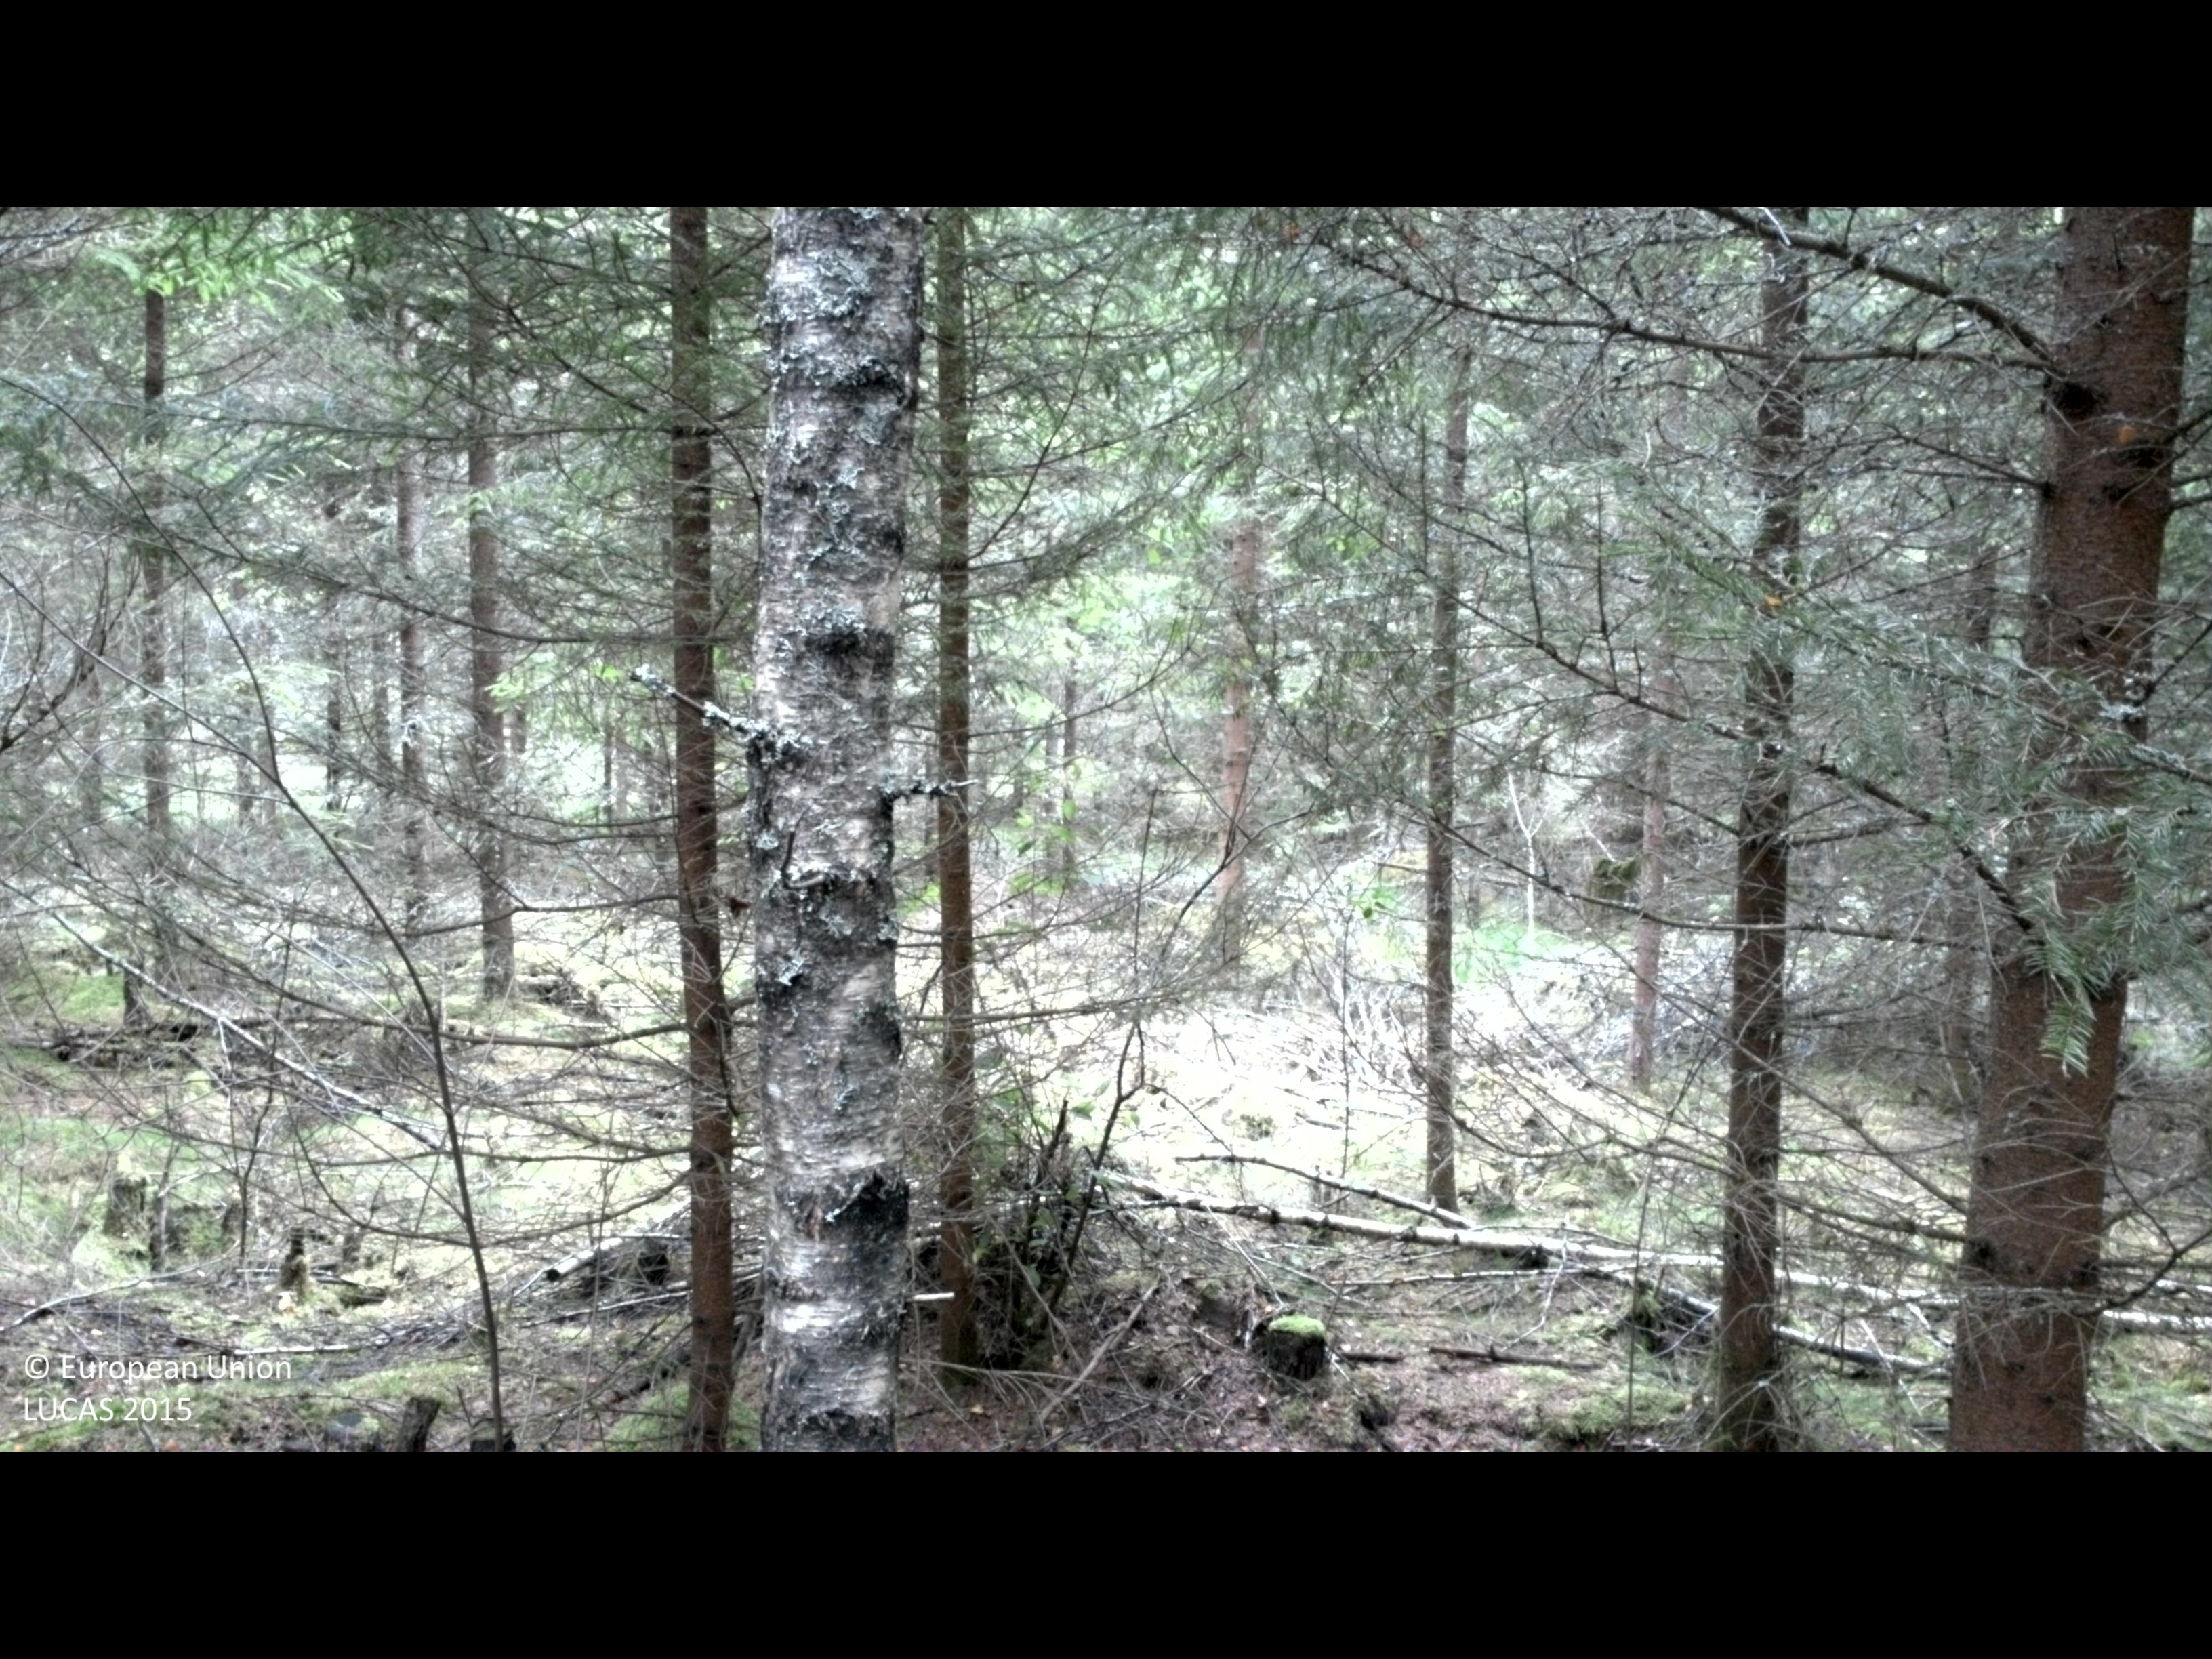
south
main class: Woodland
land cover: Spruce dominated coniferous woodland
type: boreal forest
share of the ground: > 75 %
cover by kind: coniferous forest trees 60 %, broadleaved forest trees 15 %, lichens and mosses 15 %, shrubs 10 %
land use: Forestry
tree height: > 5 m
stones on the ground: 25 - 50 %
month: July
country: SE
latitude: 56.8501
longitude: 13.8498
